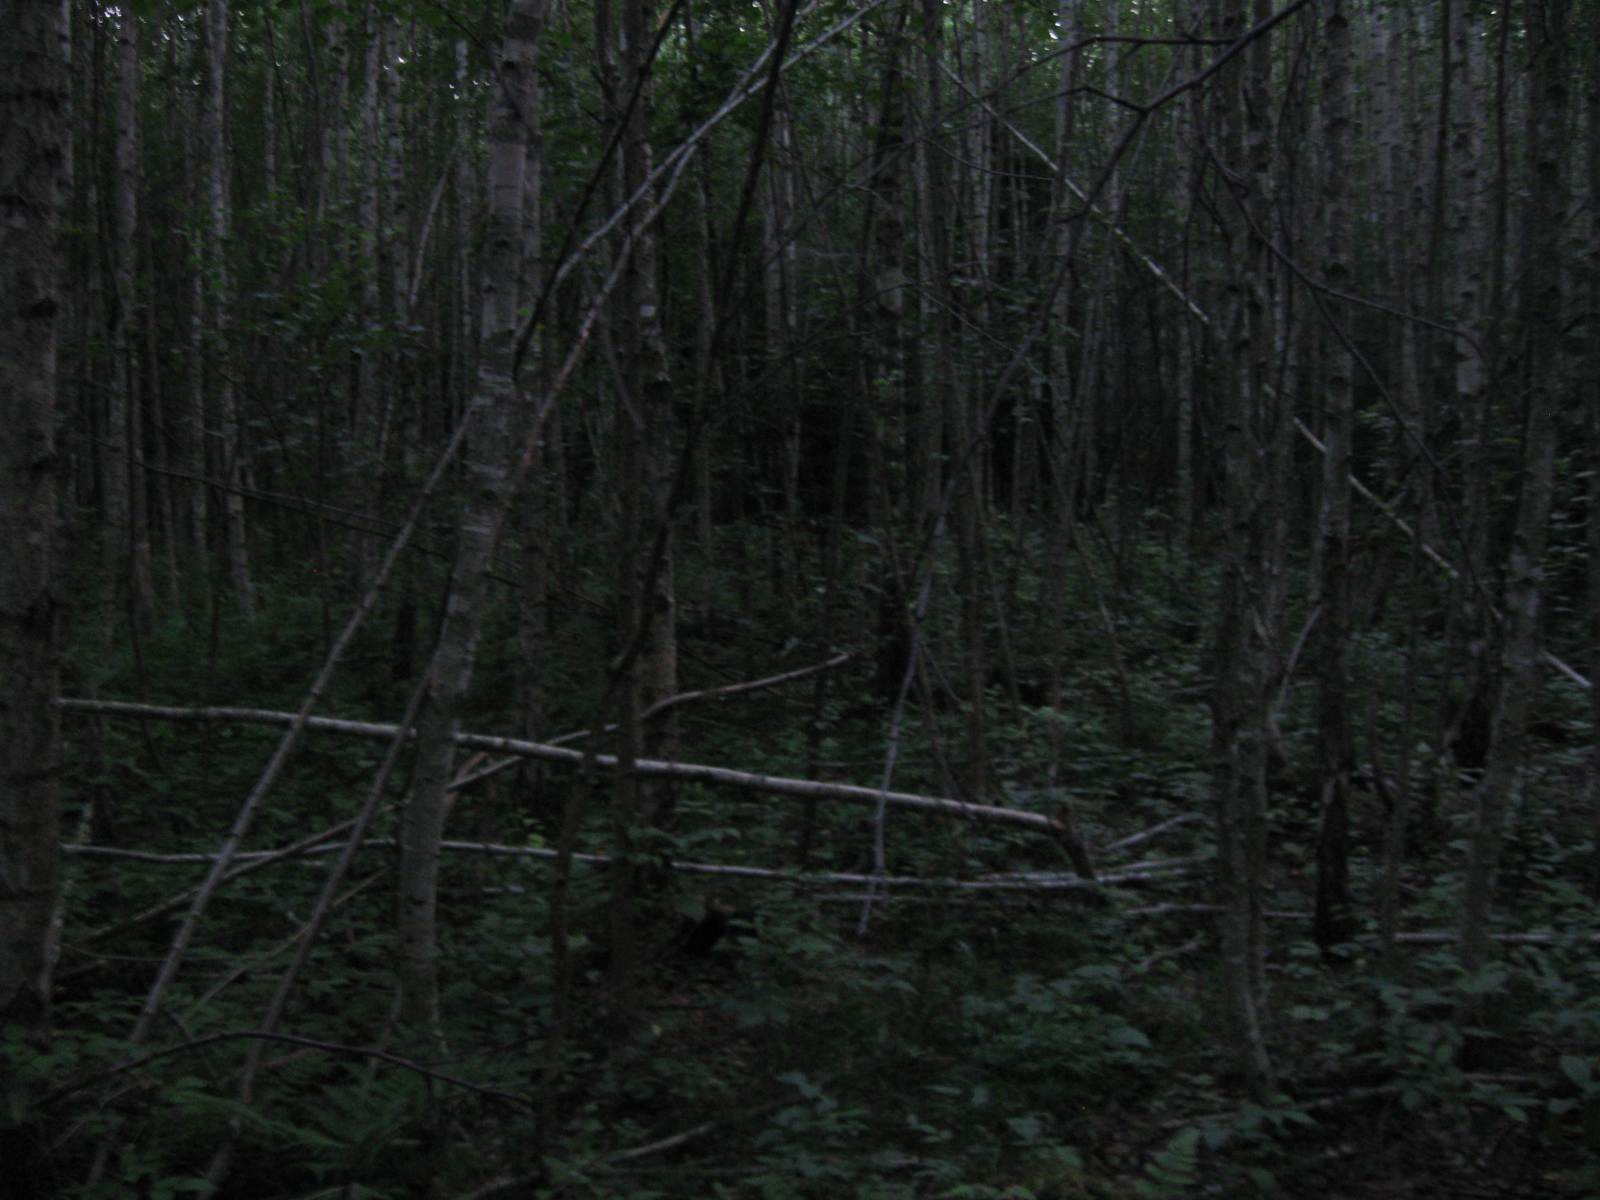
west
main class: Woodland
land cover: Broadleaved woodland
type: non-riverine alder, birch or aspen forest
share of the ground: > 75 %
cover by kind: broadleaved forest trees 85 %, herbaceous plants 10 %, shrubs 5 %
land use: Forestry
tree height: > 5 m
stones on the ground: < 10 %
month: July
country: LT
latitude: 55.0866
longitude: 23.6668
